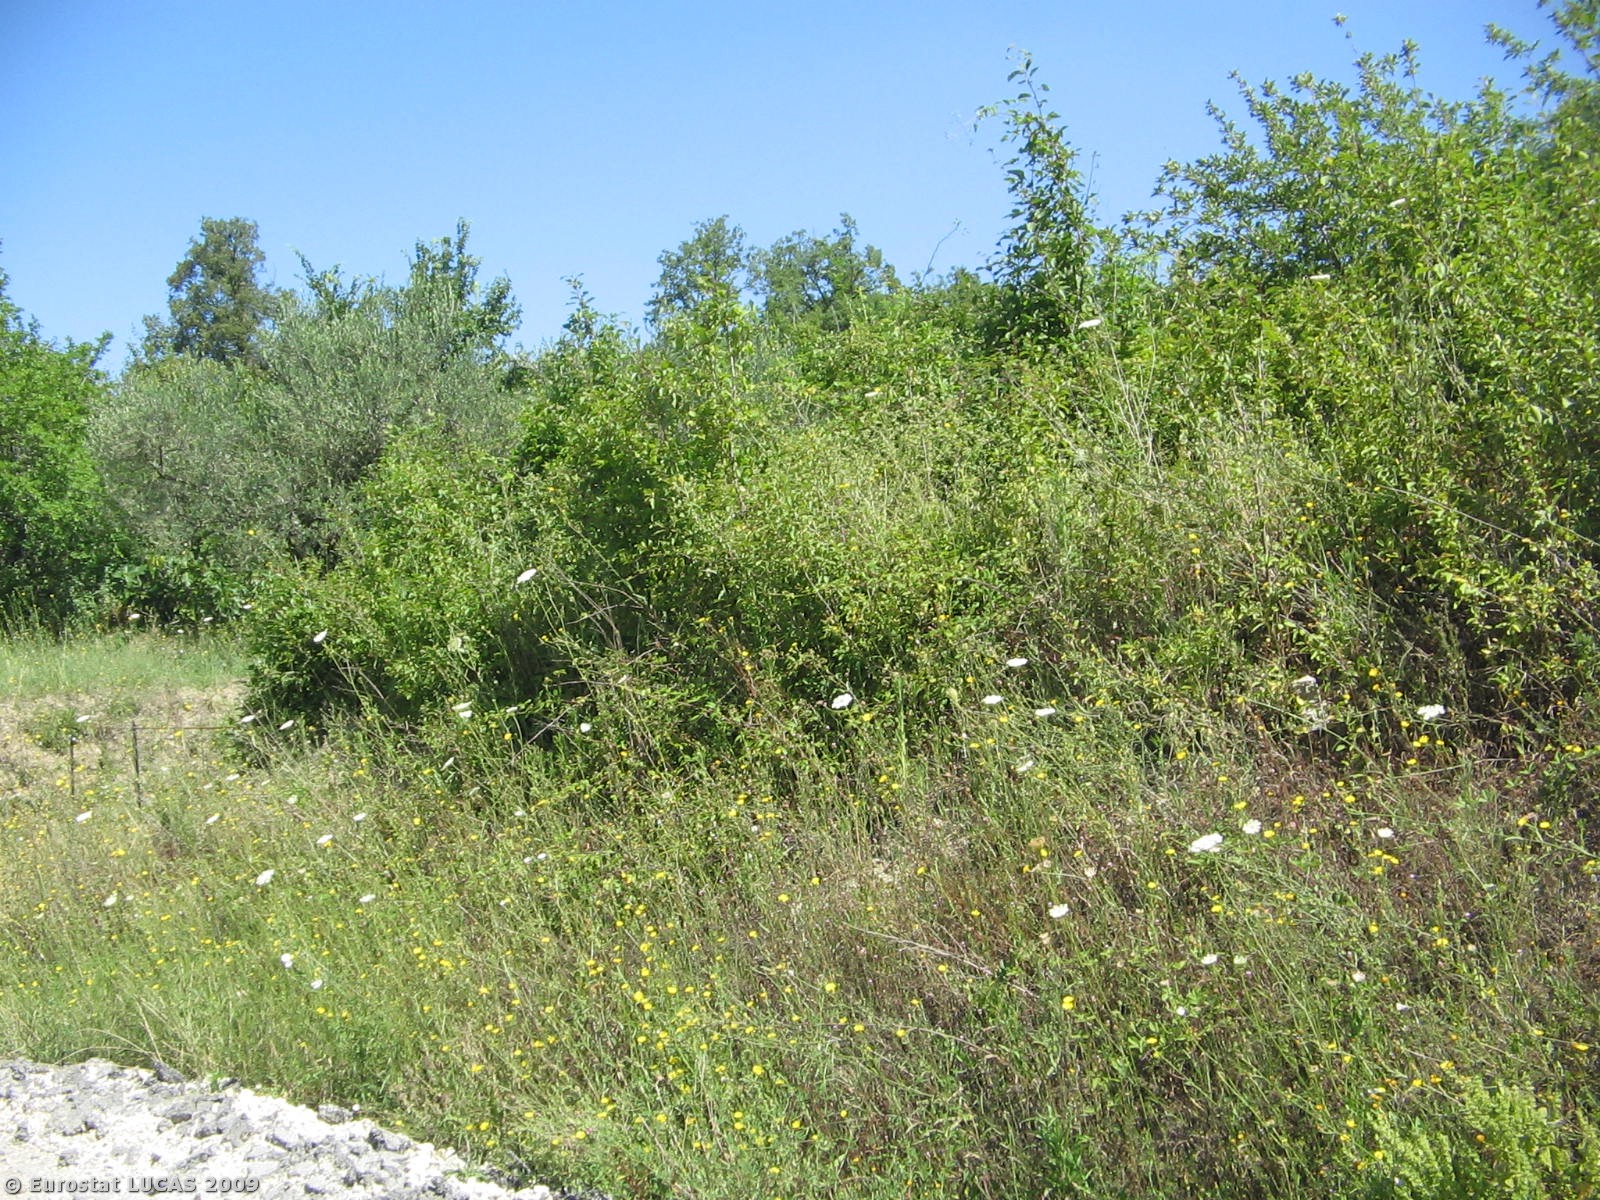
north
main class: Grassland
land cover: Grassland with sparse tree/shrub cover
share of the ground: > 75 %
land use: Agriculture (excluding fallow land and kitchen gardens)
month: July
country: IT
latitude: 41.9800
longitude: 14.3910
